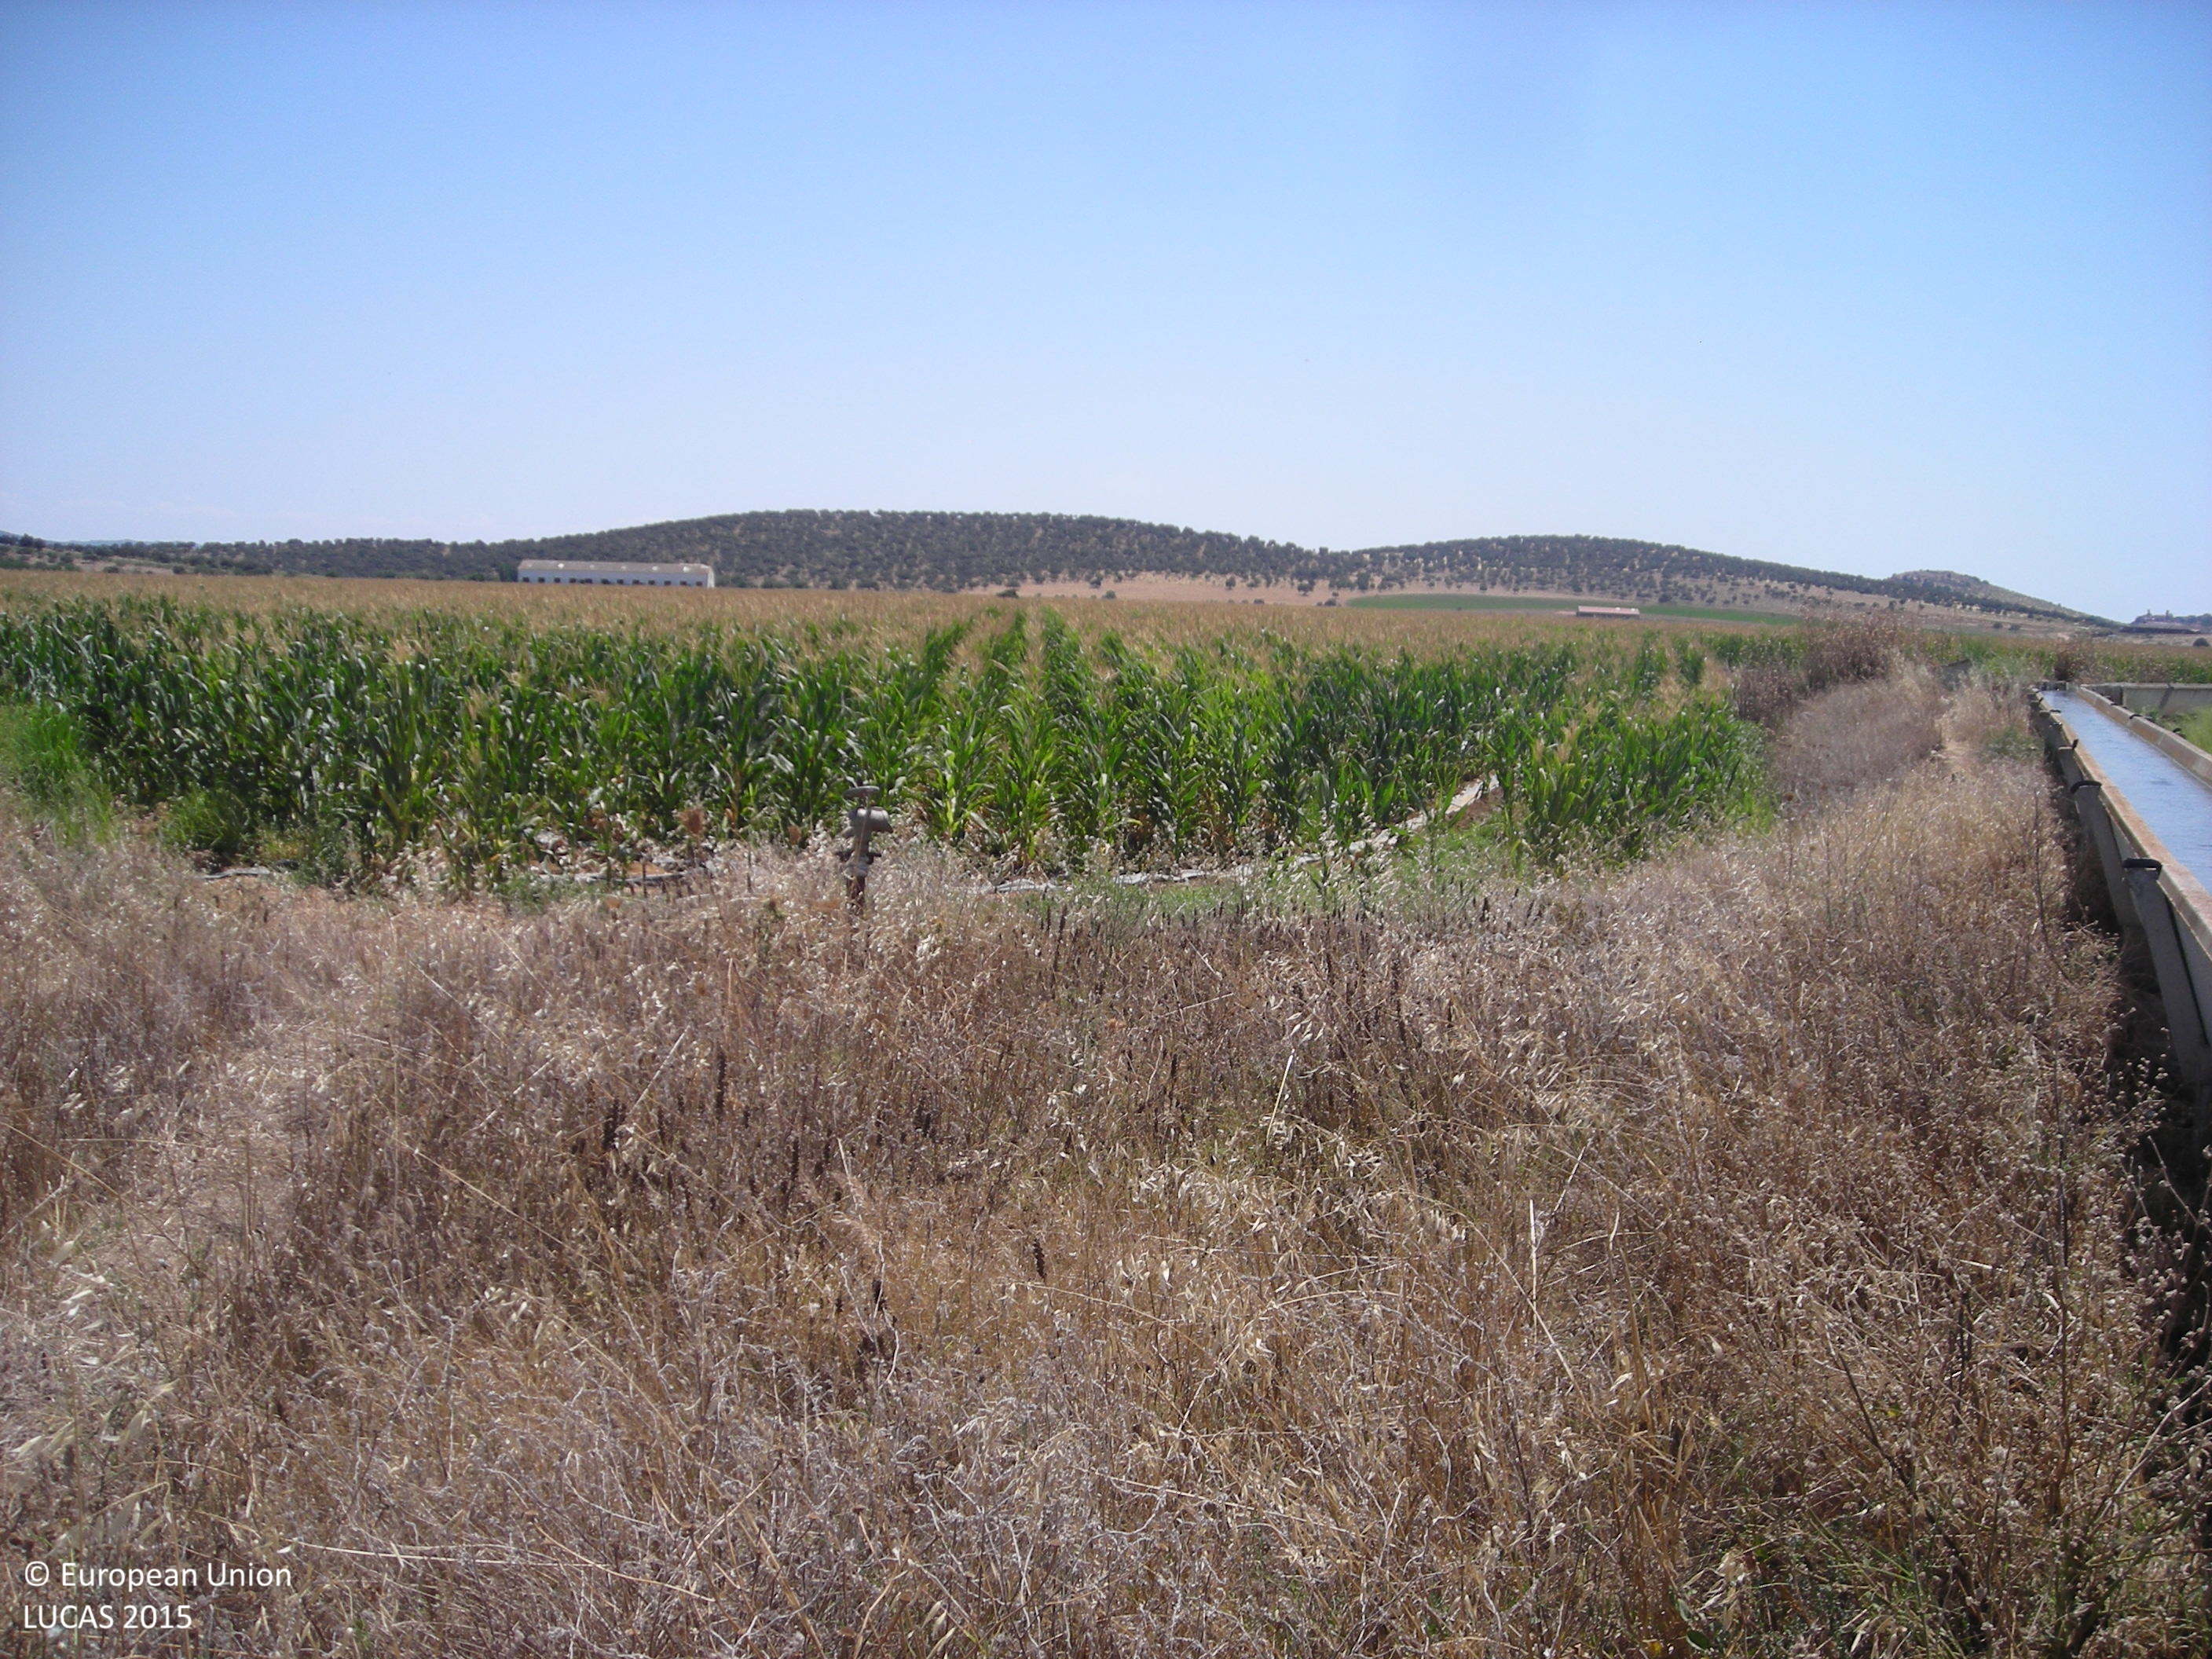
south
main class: Cropland
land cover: Rice
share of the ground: > 75 %
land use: Agriculture (excluding fallow land and kitchen gardens)
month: July
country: ES
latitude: 39.0114
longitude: -5.9308
